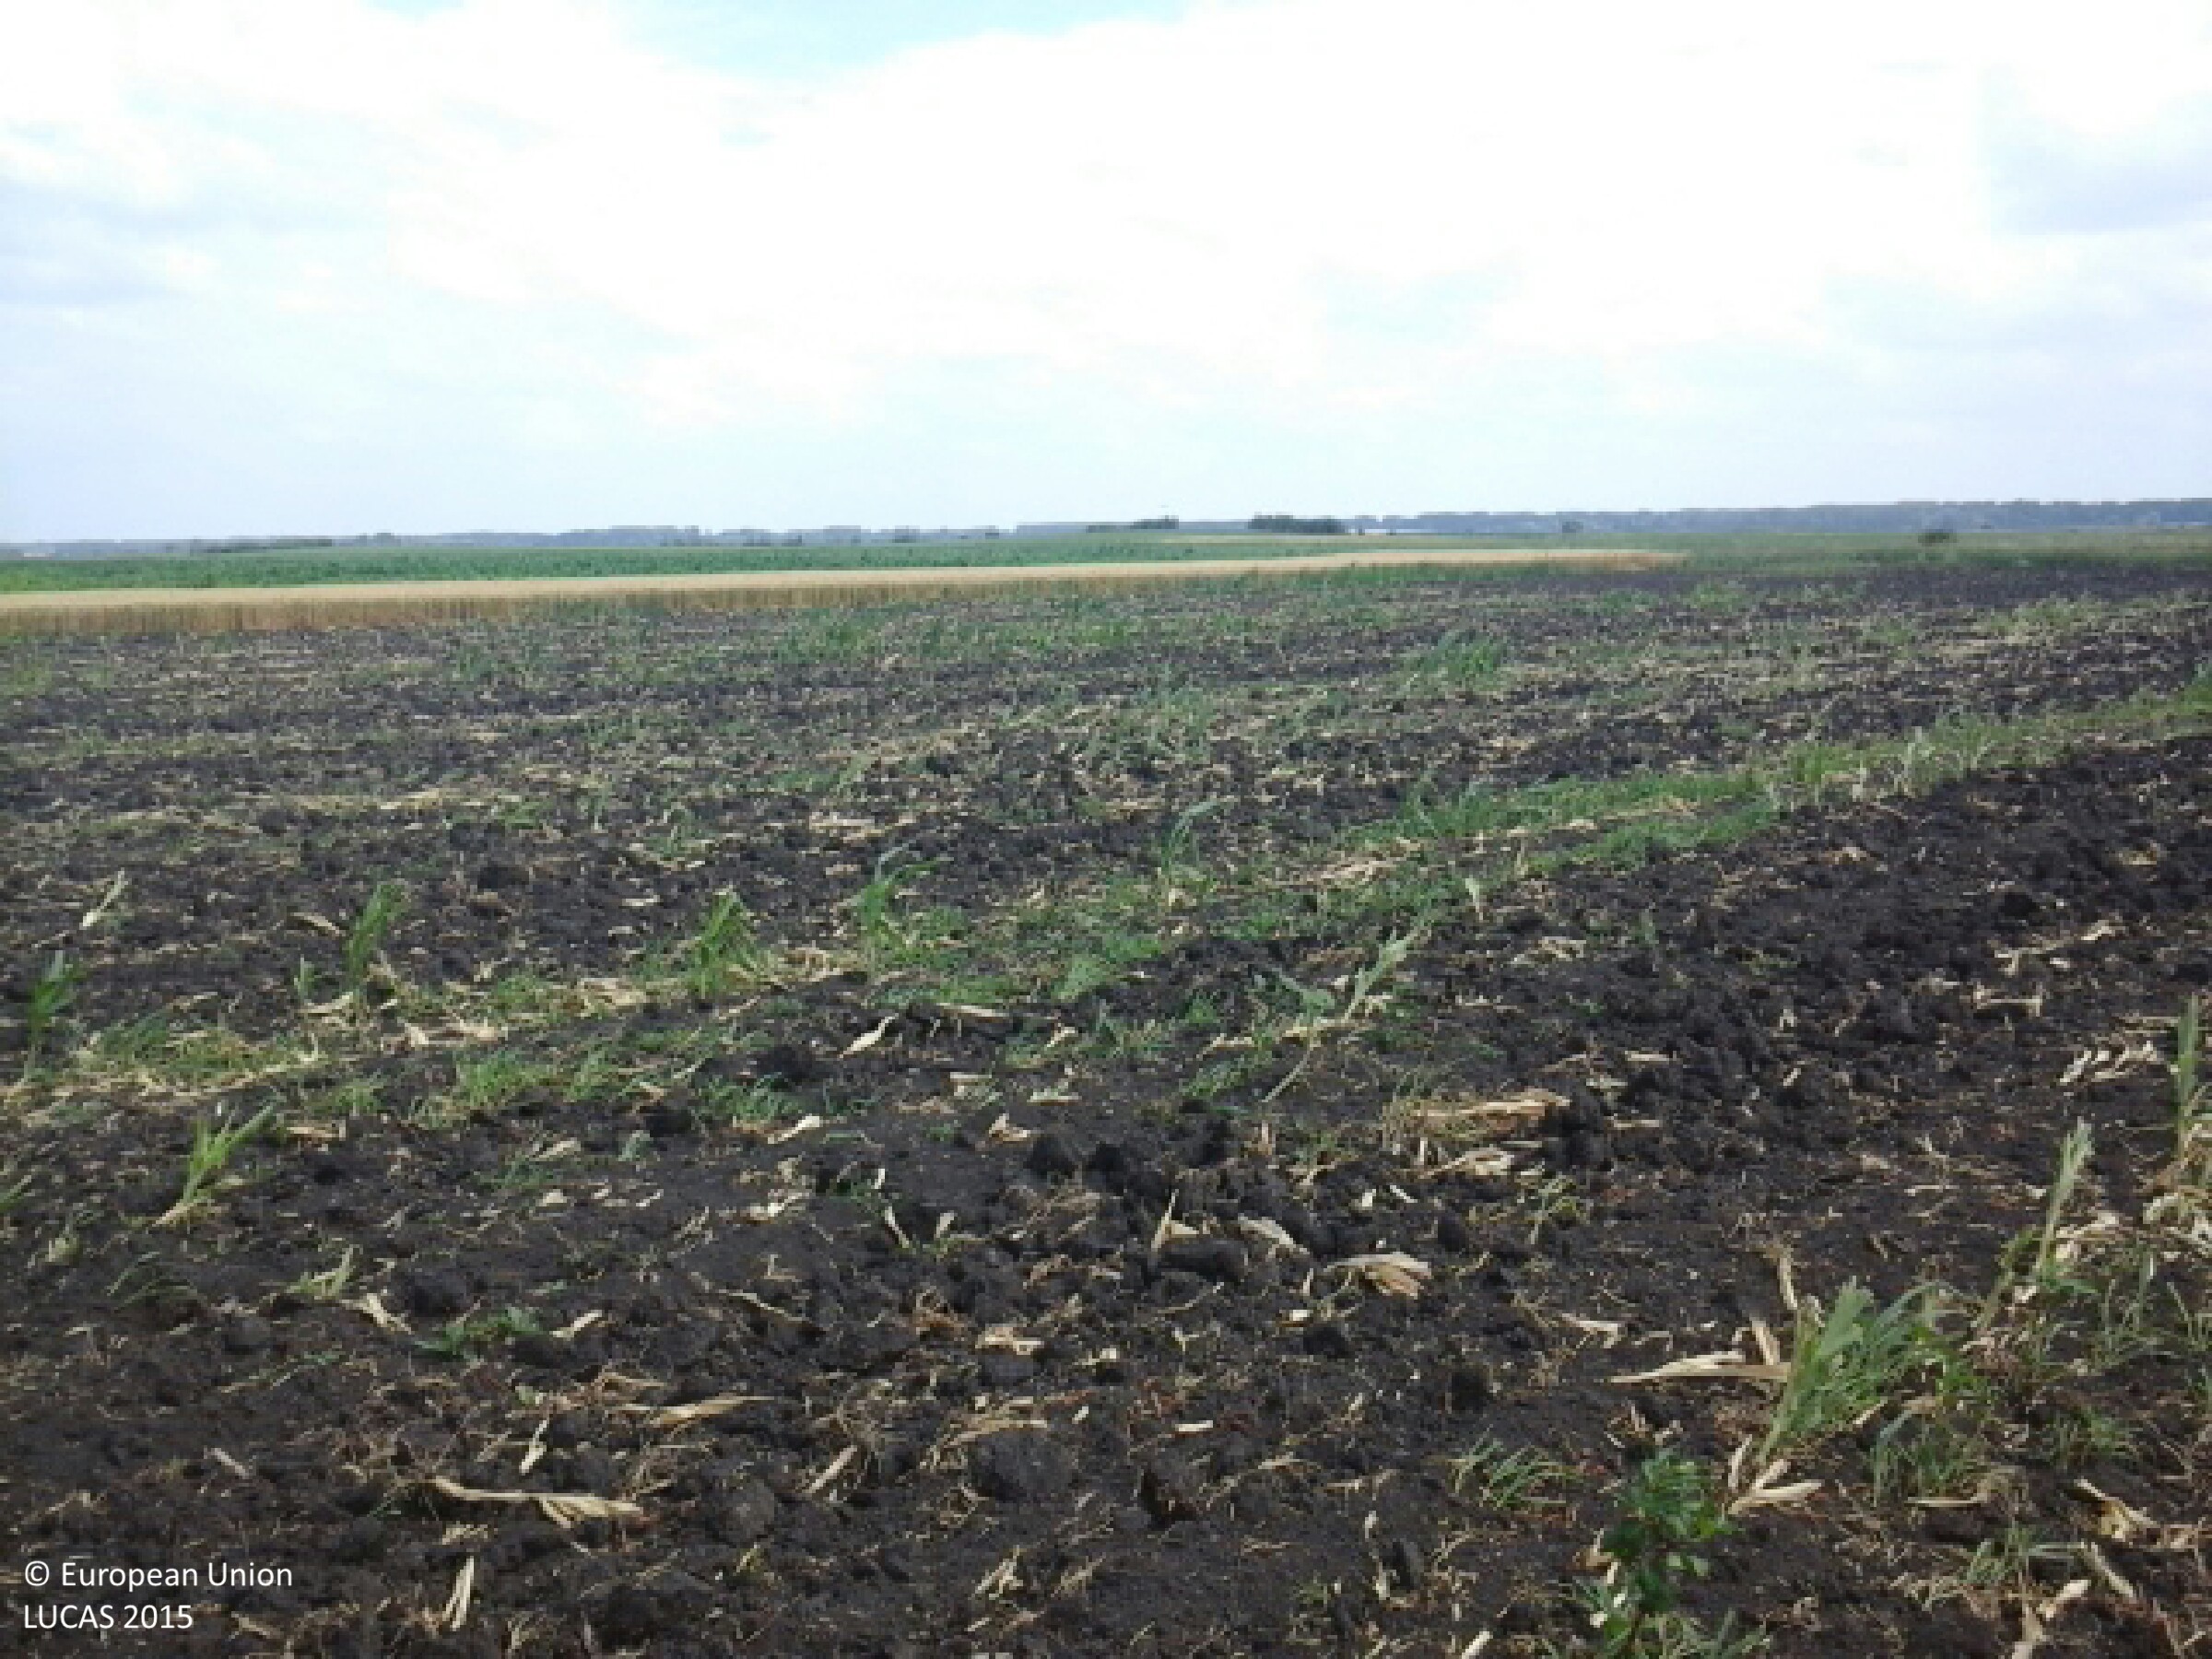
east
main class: Cropland
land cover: Maize
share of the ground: < 10 %
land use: Agriculture (excluding fallow land and kitchen gardens)
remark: Harvested field
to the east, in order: Maize; Triticale; Maize; Grass margins; Inland fresh running water; Grass margins; Tracks; Grass margins; Ditches and canals; Grass margins
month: June
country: HU
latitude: 48.2293
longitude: 21.7481
